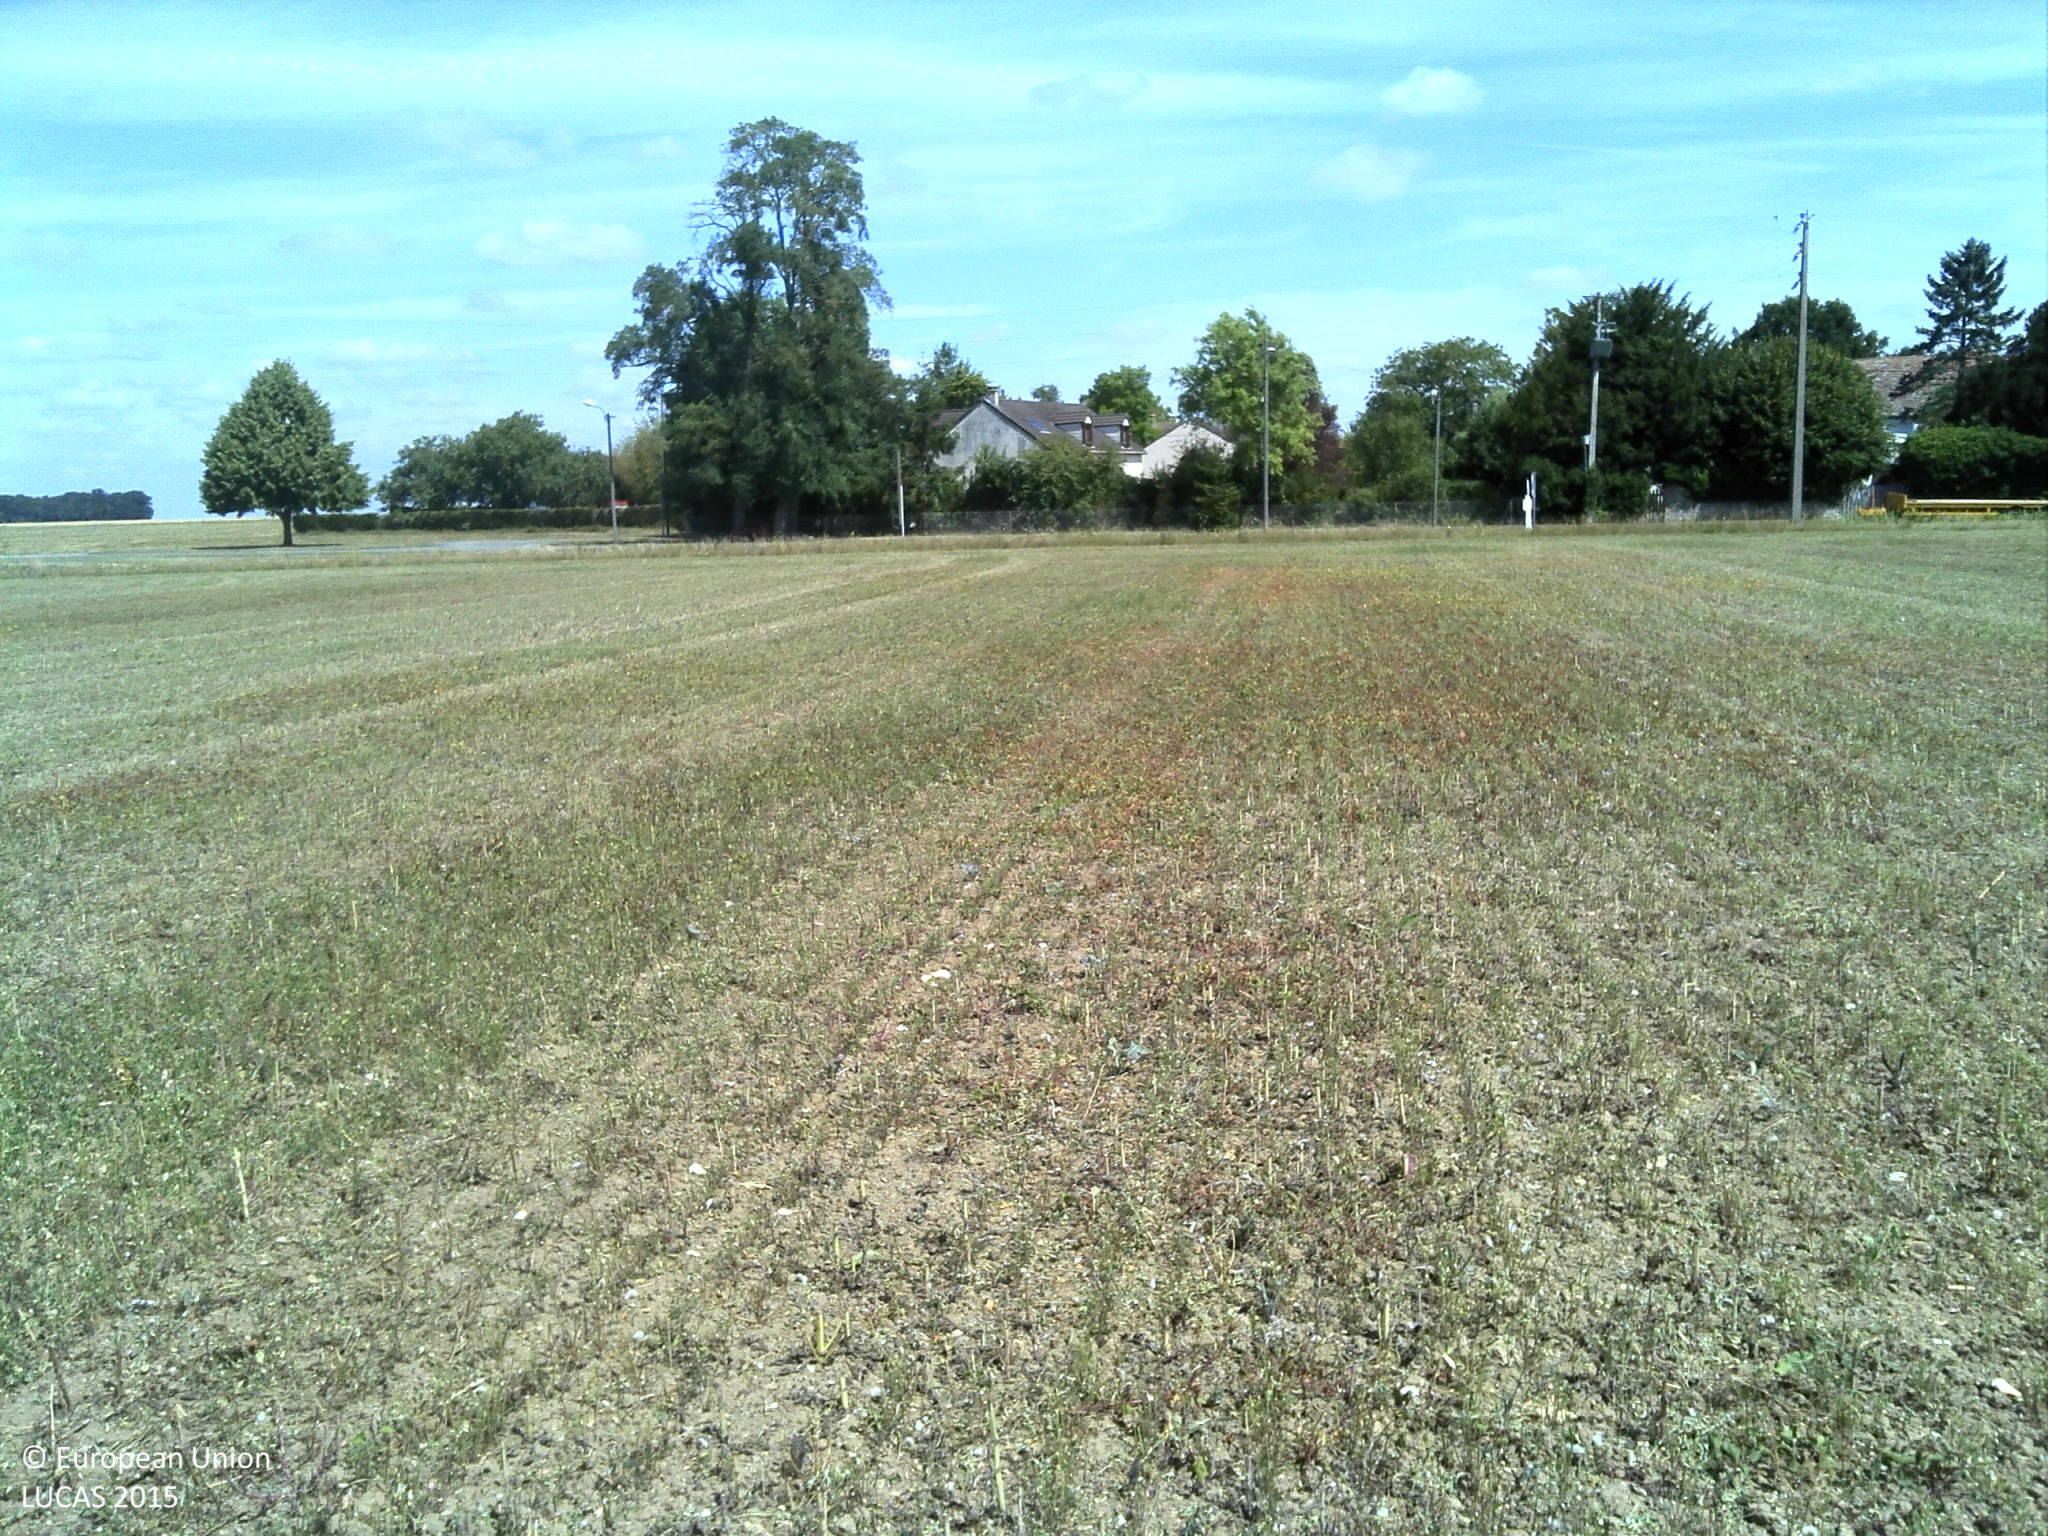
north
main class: Cropland
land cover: Temporary grasslands
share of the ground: > 75 %
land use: Agriculture (excluding fallow land and kitchen gardens)
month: July
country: FR
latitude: 48.5558
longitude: 1.8699
